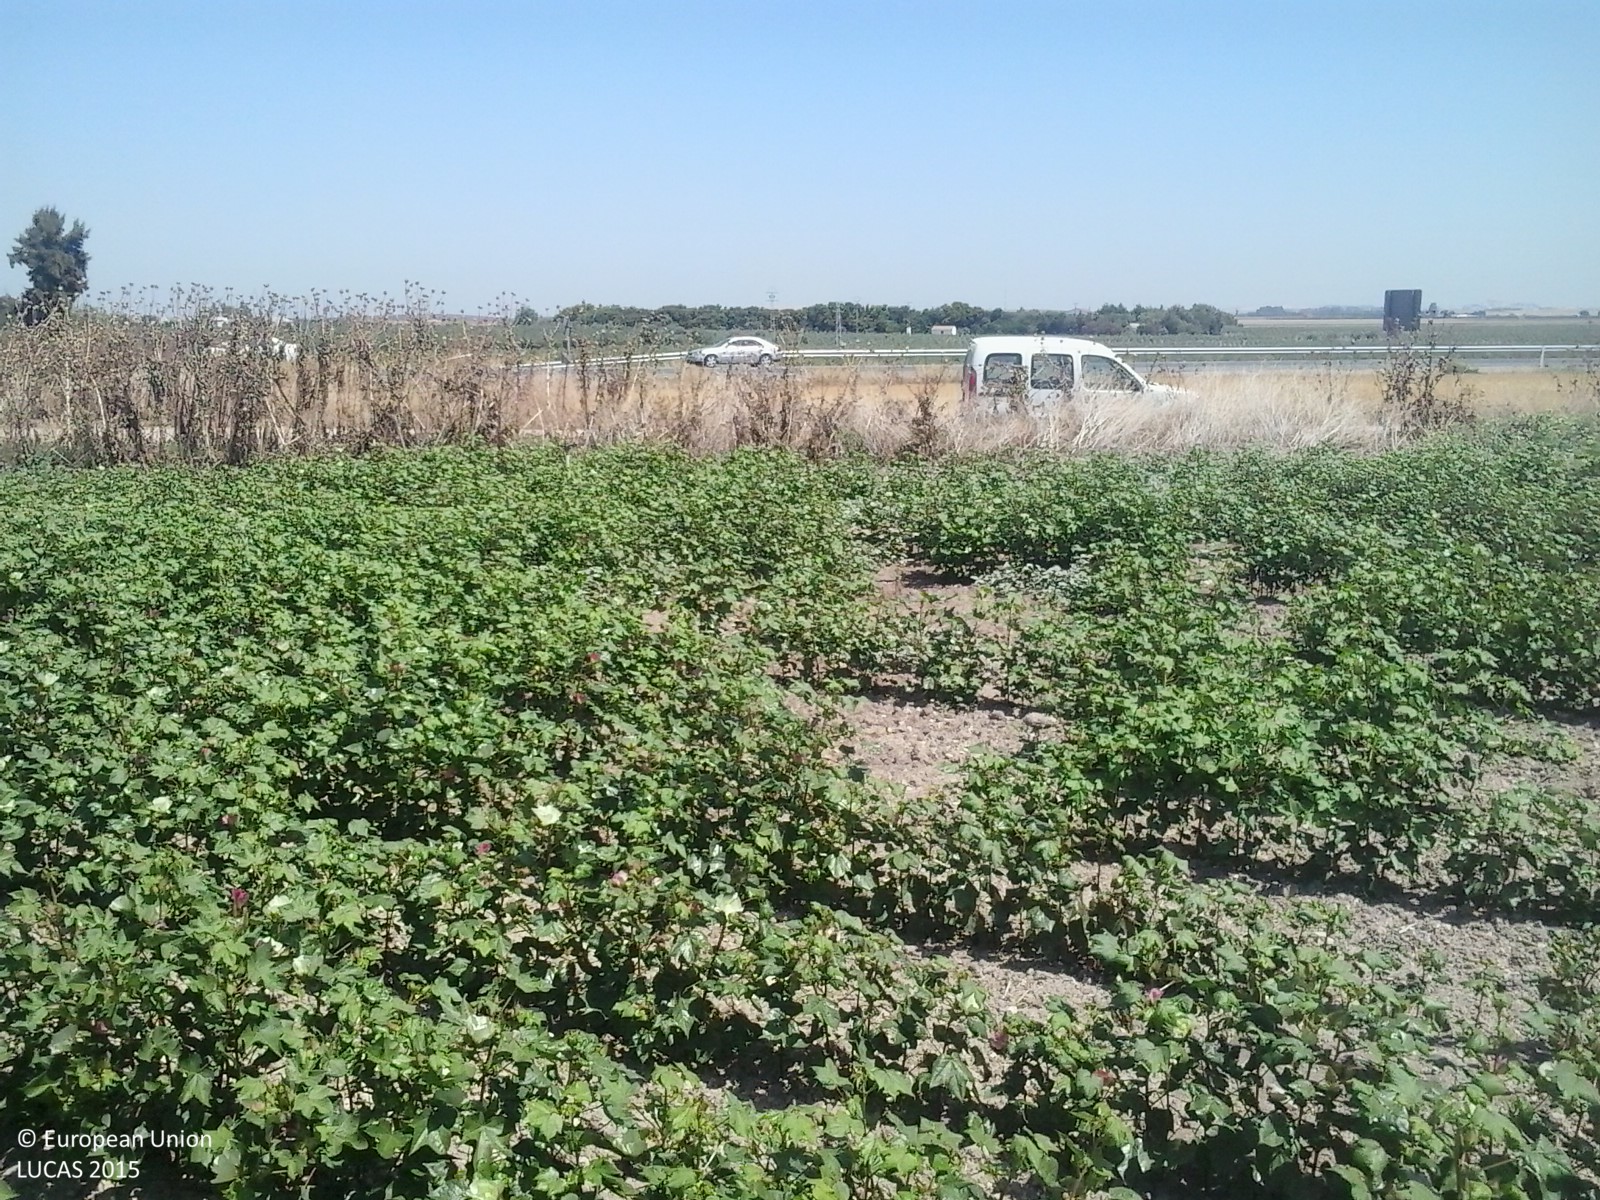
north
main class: Cropland
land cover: Cotton
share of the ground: 50 - 75 %
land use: Agriculture (excluding fallow land and kitchen gardens)
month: July
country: ES
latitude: 36.9024
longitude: -5.9840
